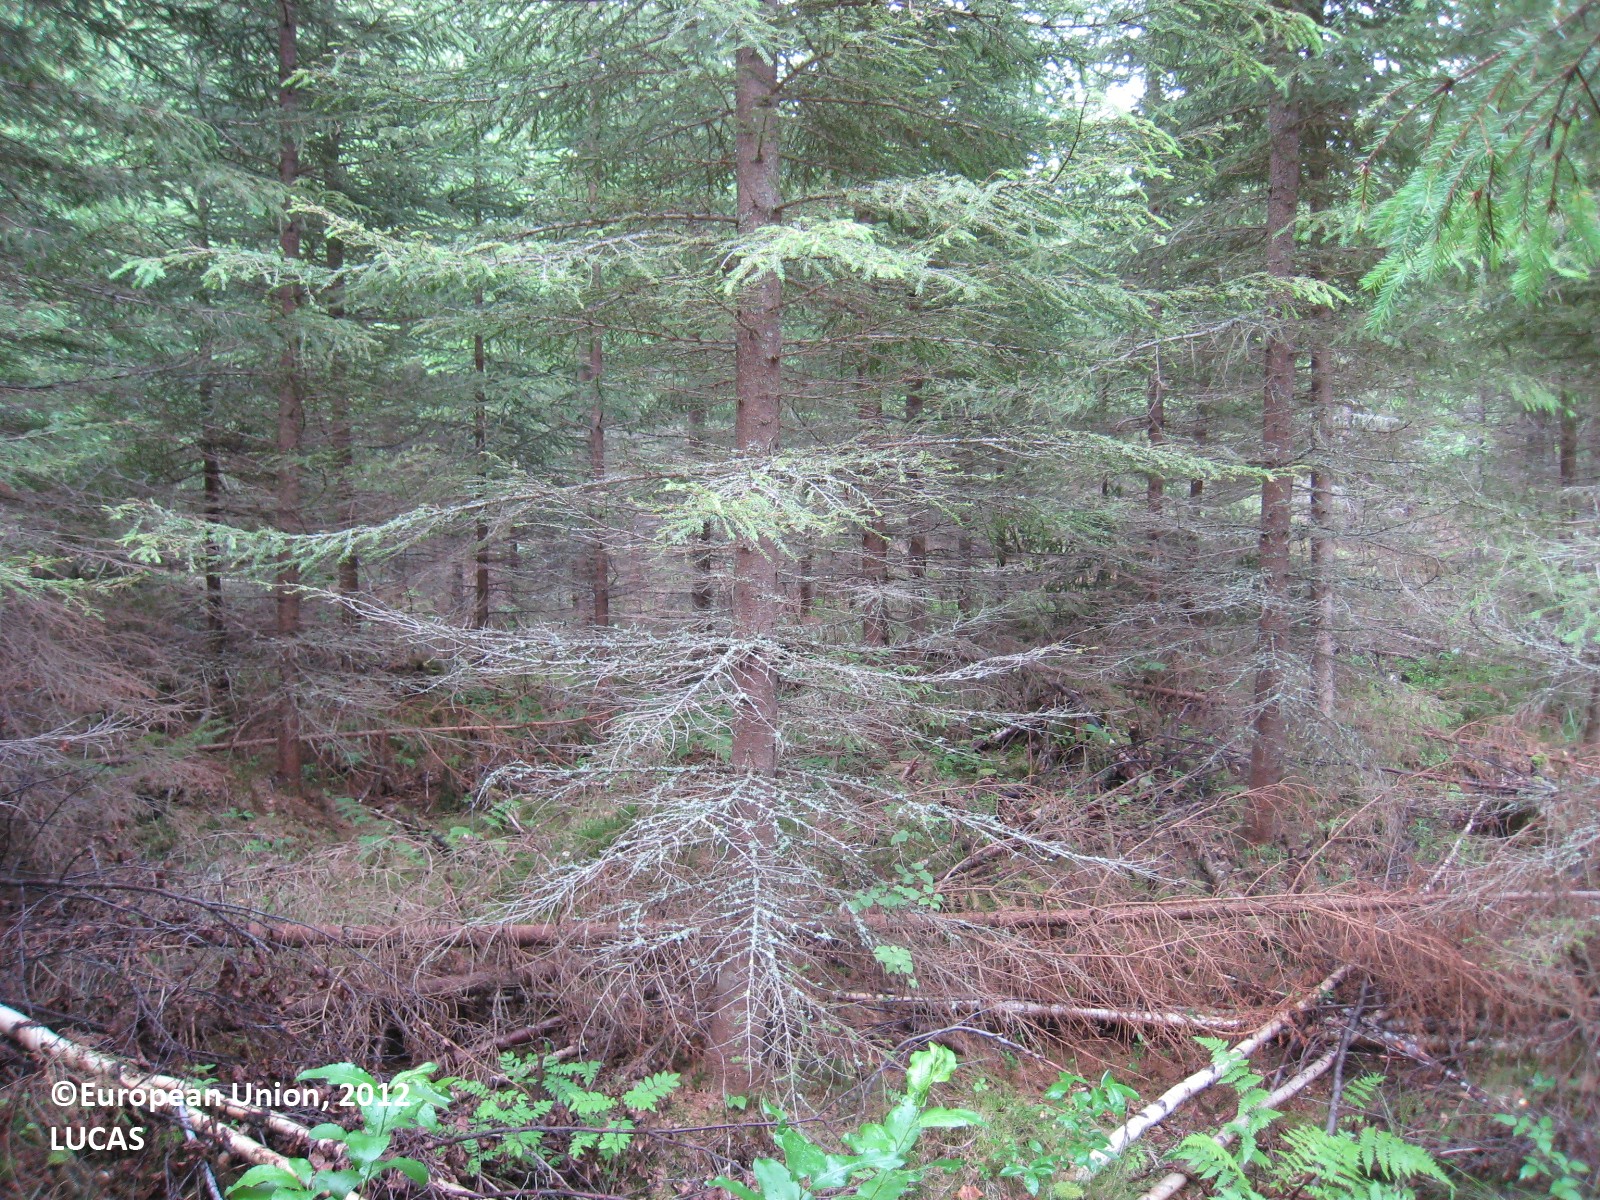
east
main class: Woodland
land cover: Spruce dominated coniferous woodland
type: boreal forest
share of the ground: > 75 %
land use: Forestry
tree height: > 5 m
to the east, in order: Spruce dominated coniferous woodland; Ditches and canals; Spruce dominated coniferous woodland; Ditches and canals; Spruce dominated coniferous woodland; Ditches and canals; Spruce dominated mixed woodland; Broadleaved woodland; Spruce dominated mixed woodland
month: July
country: FI
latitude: 61.7677
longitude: 27.2796
